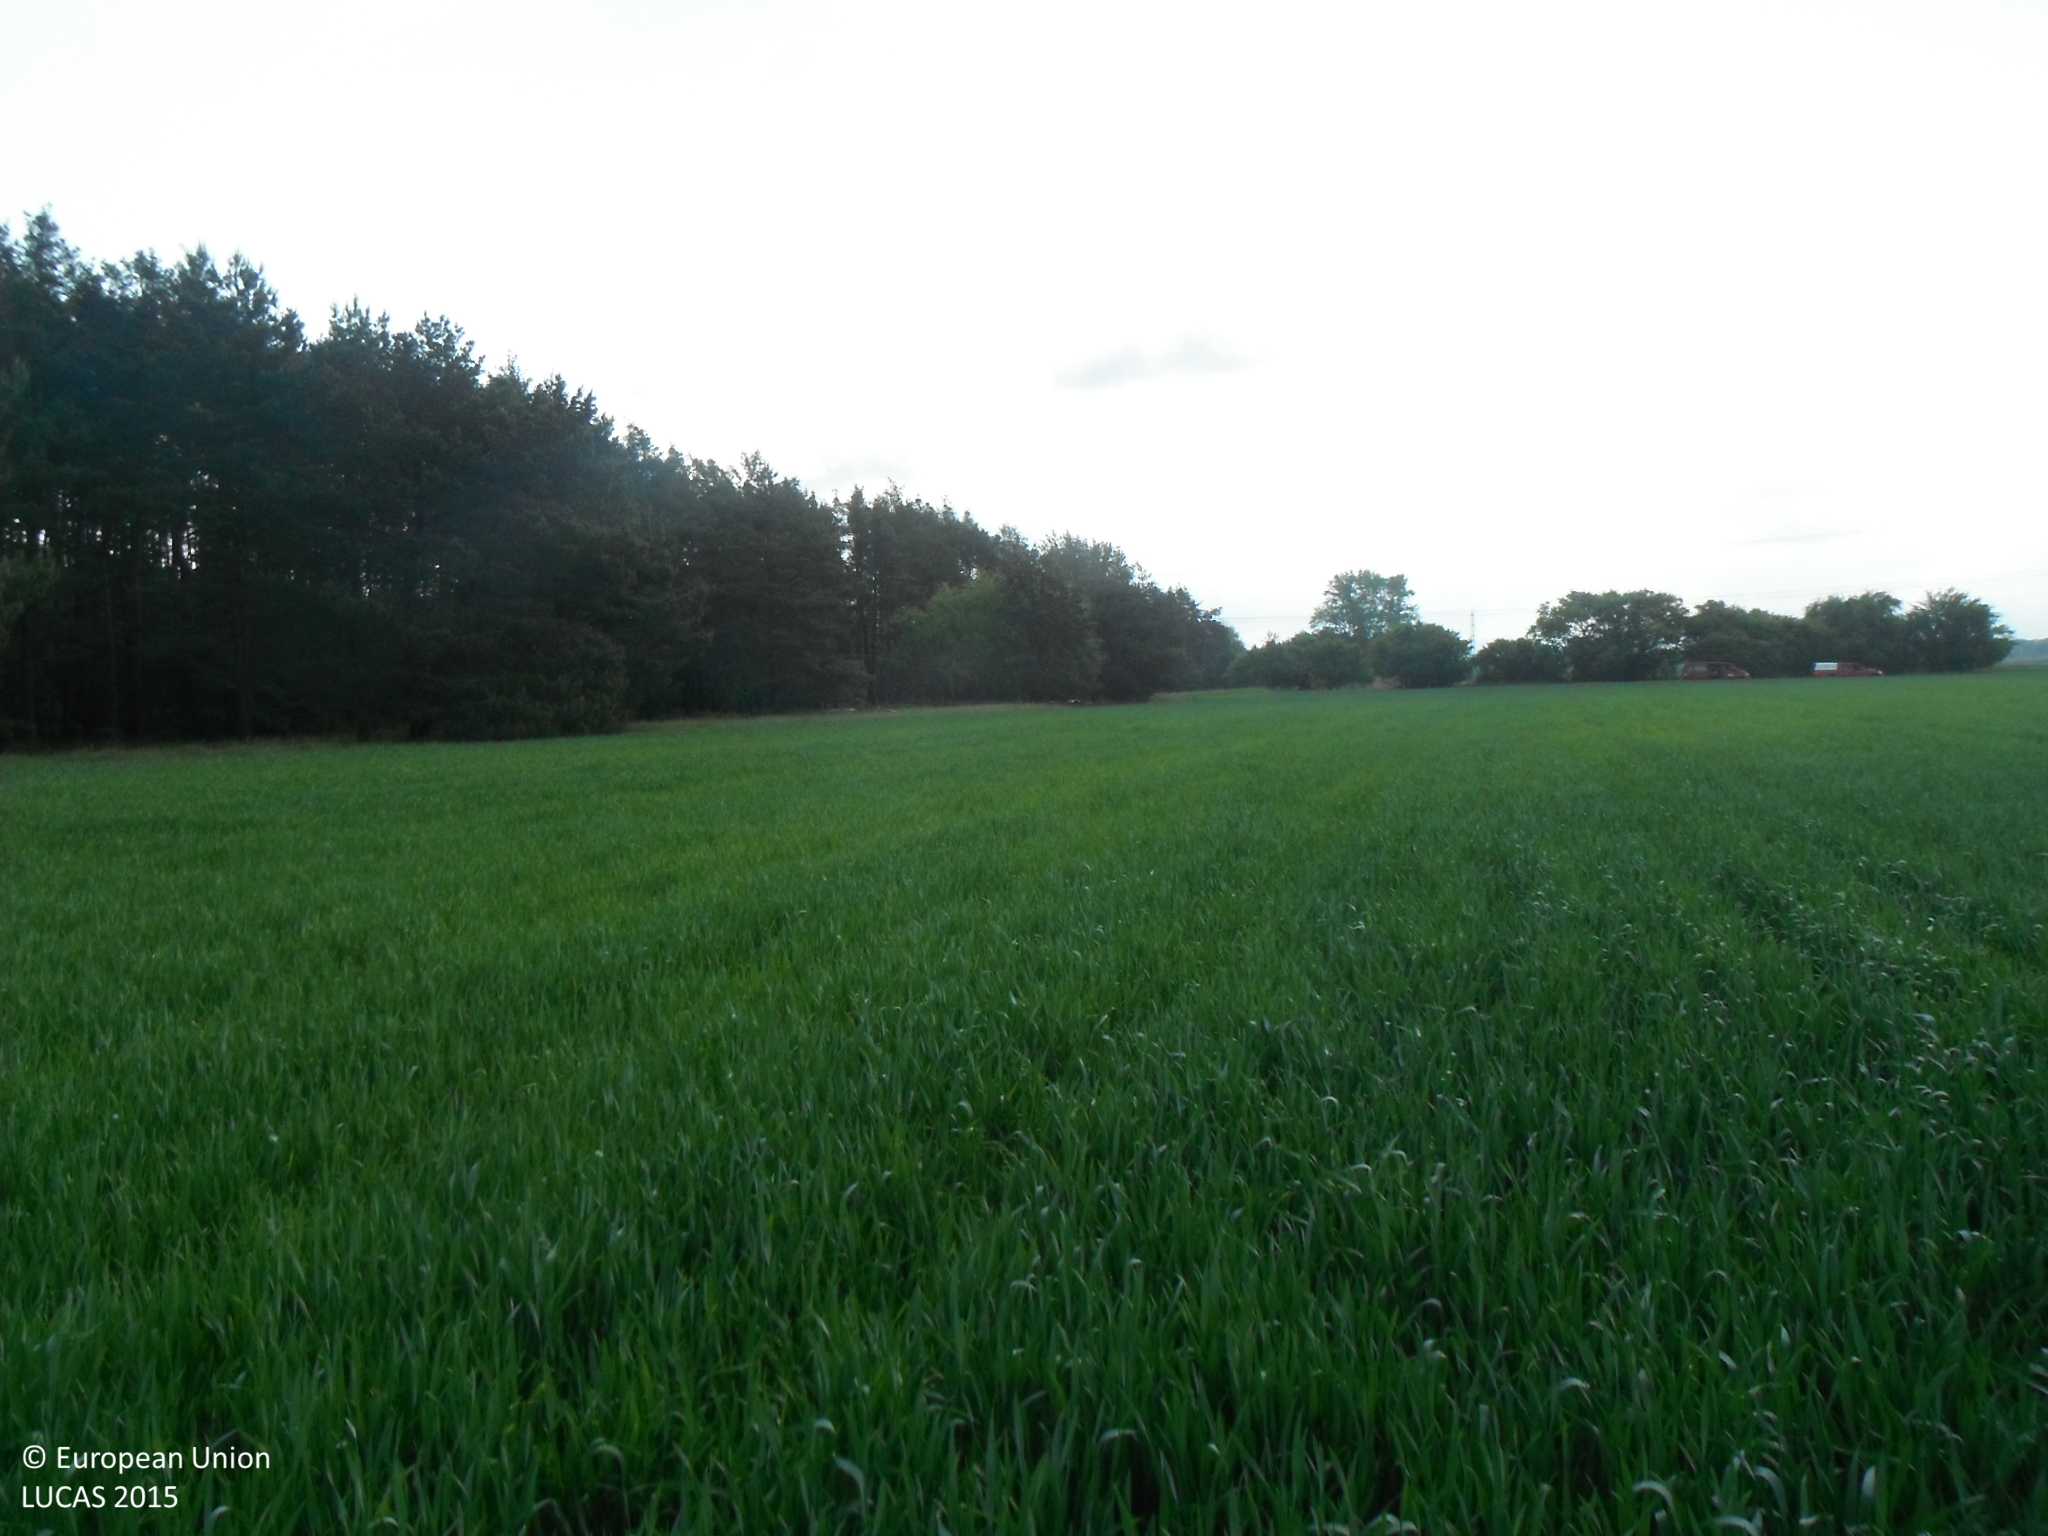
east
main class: Cropland
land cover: Common wheat
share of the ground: > 75 %
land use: Agriculture (excluding fallow land and kitchen gardens)
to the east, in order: Common wheat; Pine dominated coniferous woodland; Spontaneously vegetated surfaces; Tracks; Pine dominated coniferous woodland; Broadleaved woodland
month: May
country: SK
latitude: 48.4704
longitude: 17.0009
